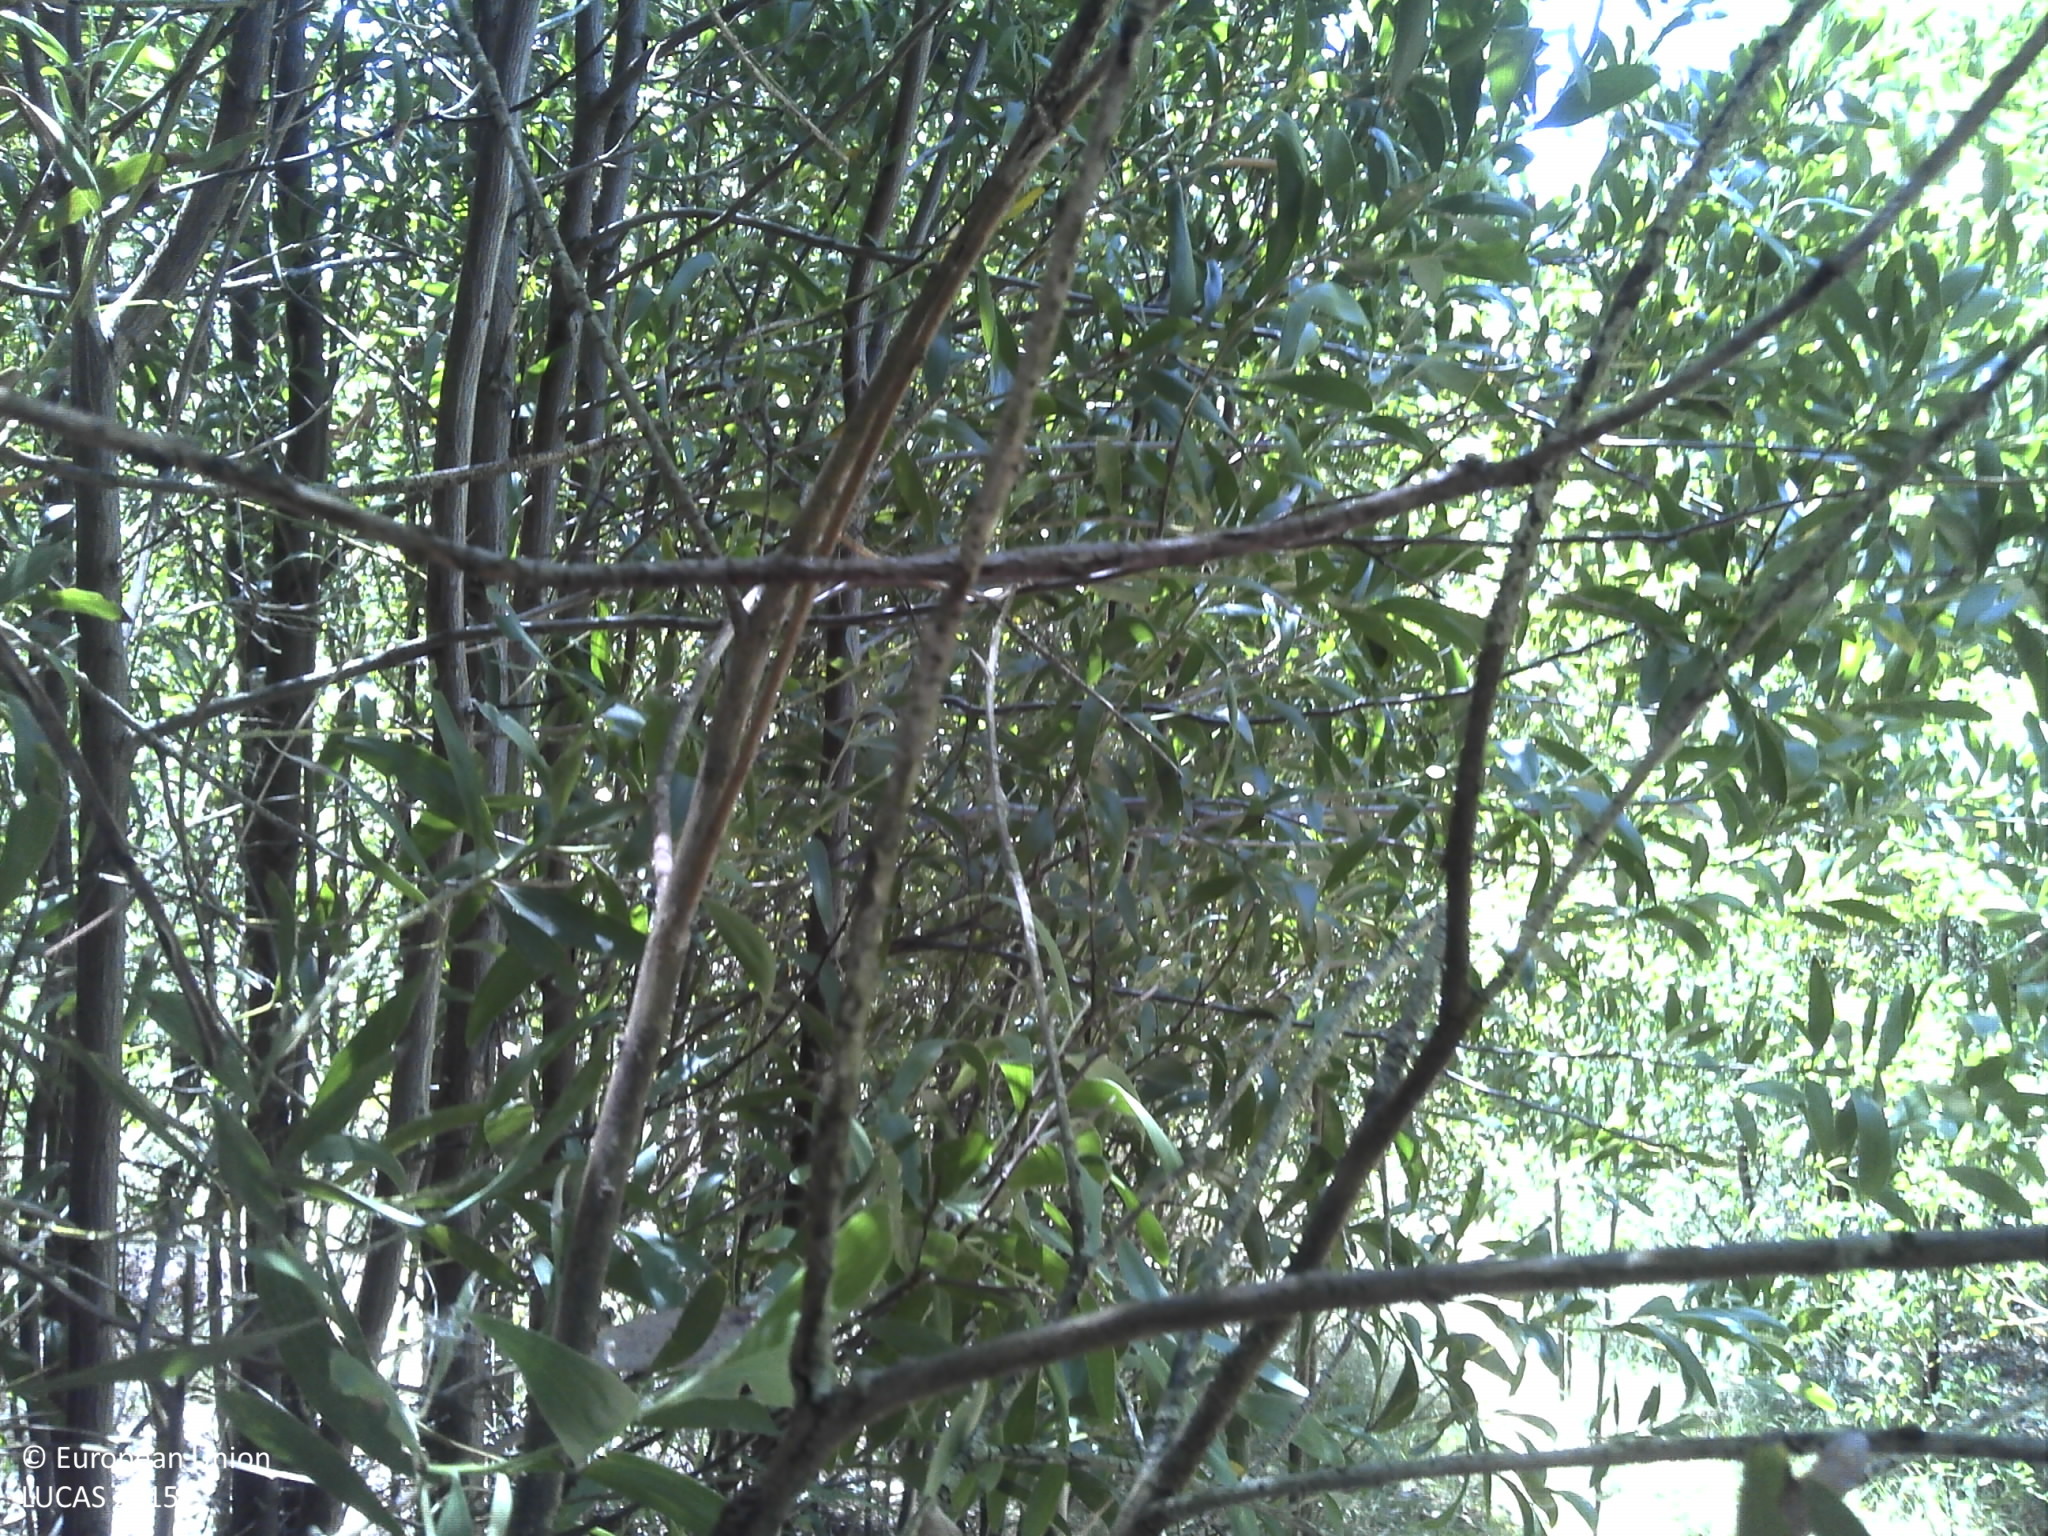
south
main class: Woodland
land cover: Broadleaved woodland
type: exotic forest
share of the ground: > 75 %
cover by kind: broadleaved forest trees 80 %, shrubs 10 %, herbaceous plants 5 %, unconsolidated bare surface 5 %
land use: Forestry
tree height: > 5 m
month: May
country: PT
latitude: 40.5131
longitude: -8.6602
